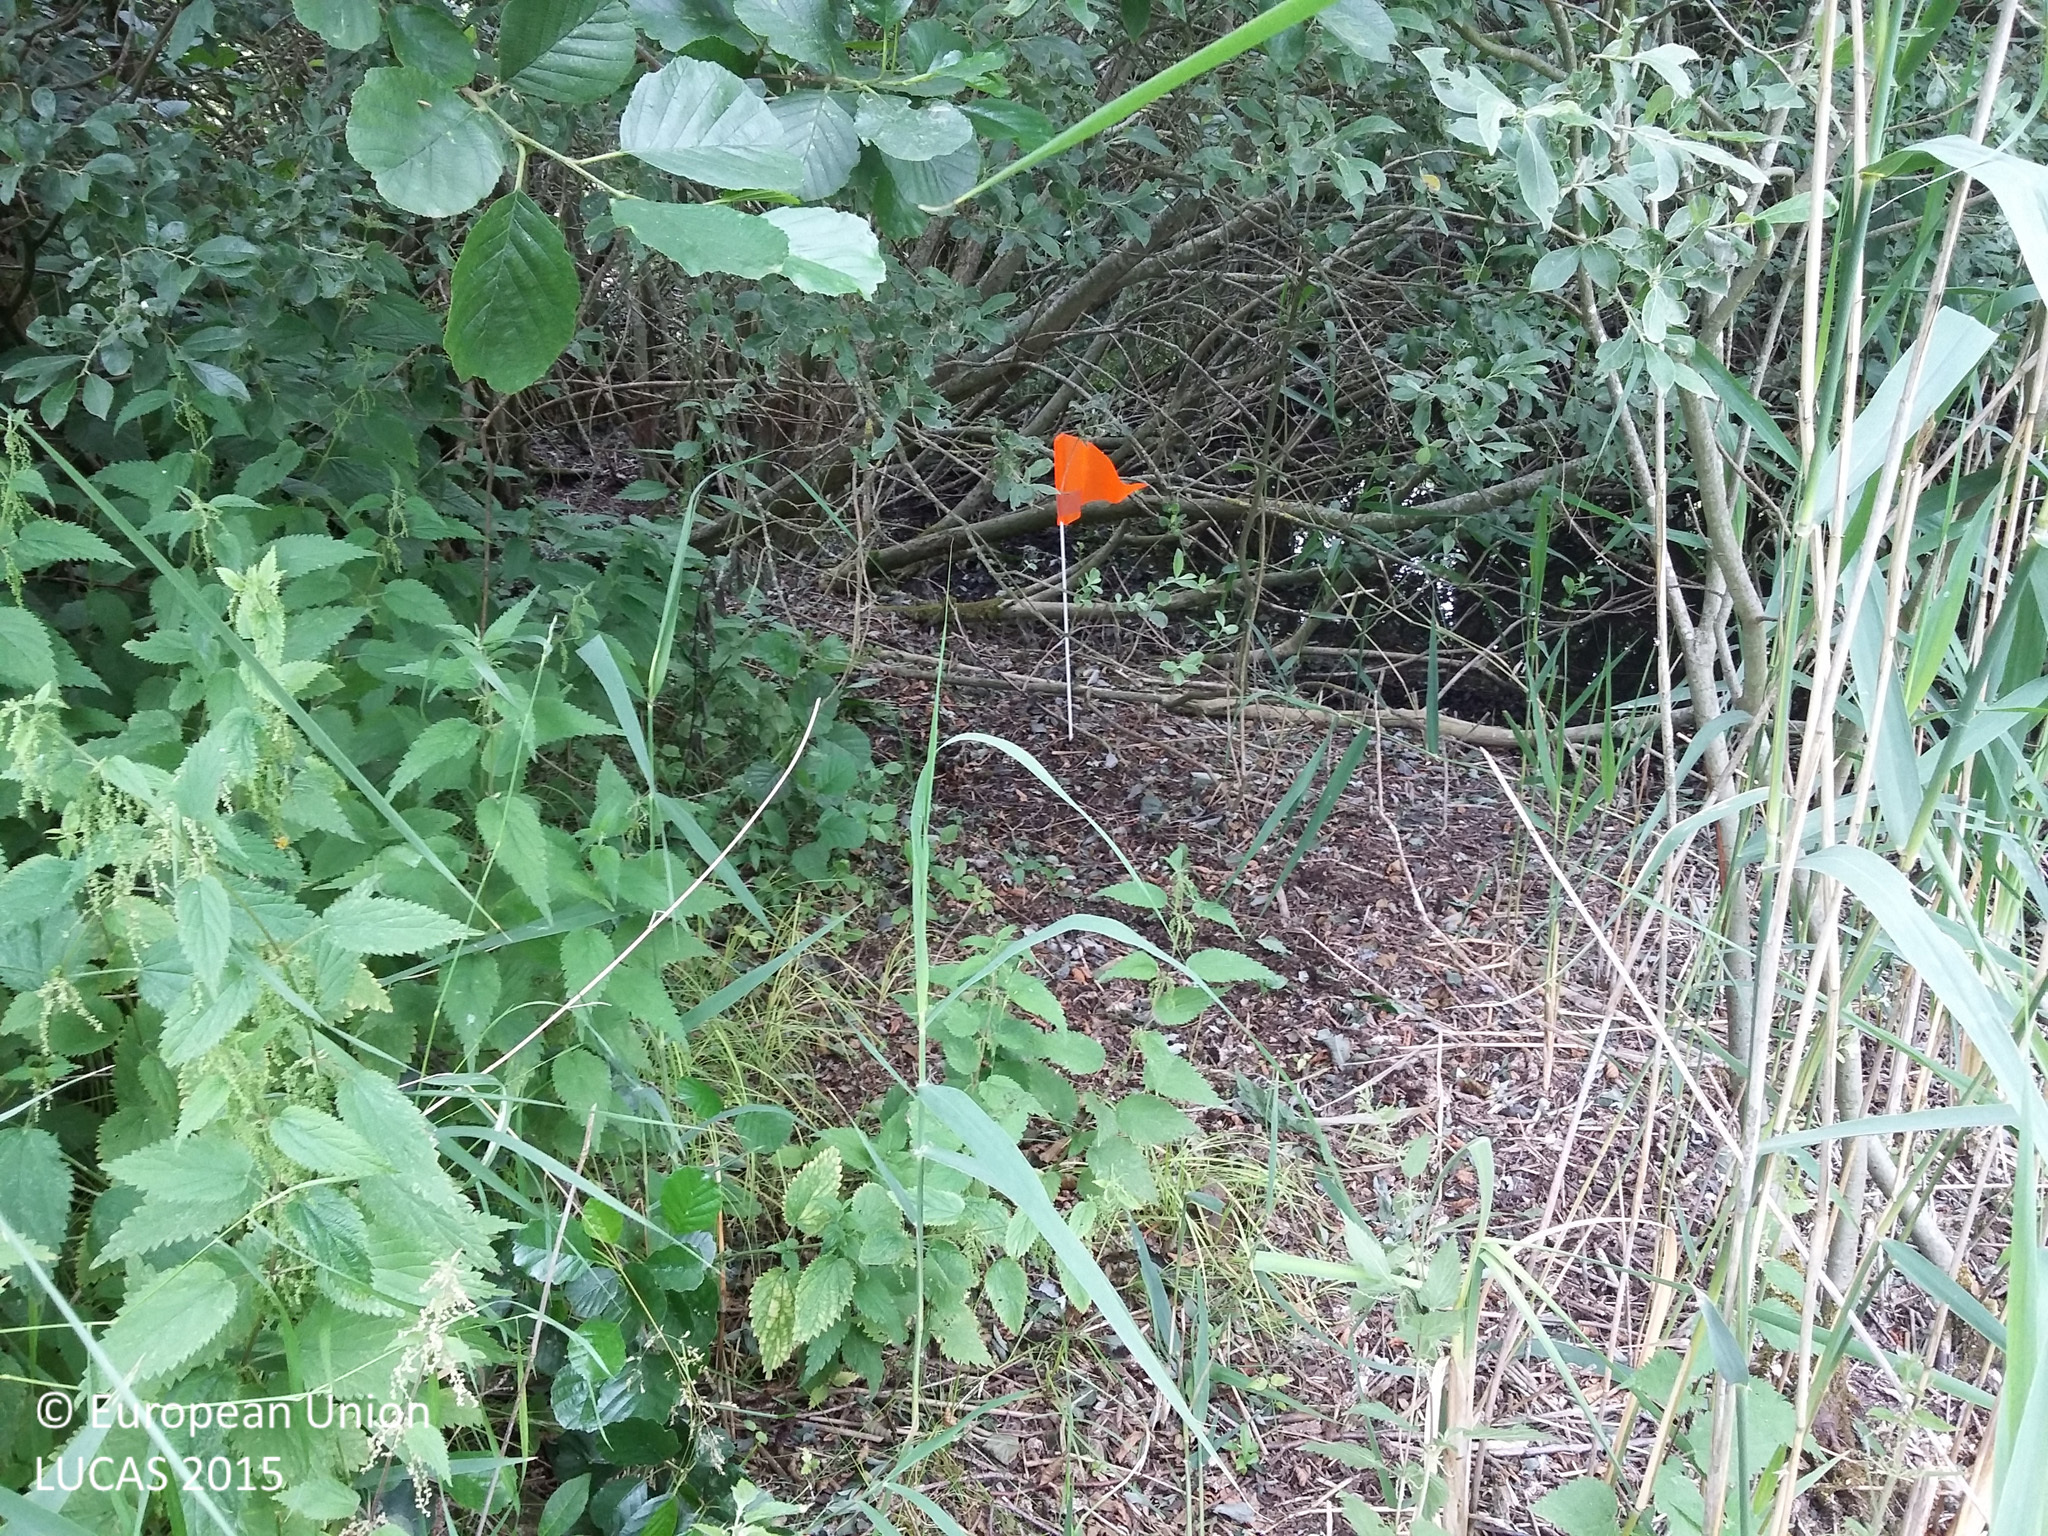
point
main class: Woodland
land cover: Broadleaved woodland
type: mire and swamp forests
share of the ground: > 75 %
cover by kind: broadleaved forest trees 85 %, herbaceous plants 10 %, lichens and mosses 5 %
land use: Semi-natural and natural areas not in use
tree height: > 5 m
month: July
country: DK
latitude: 55.4979
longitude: 11.3127
